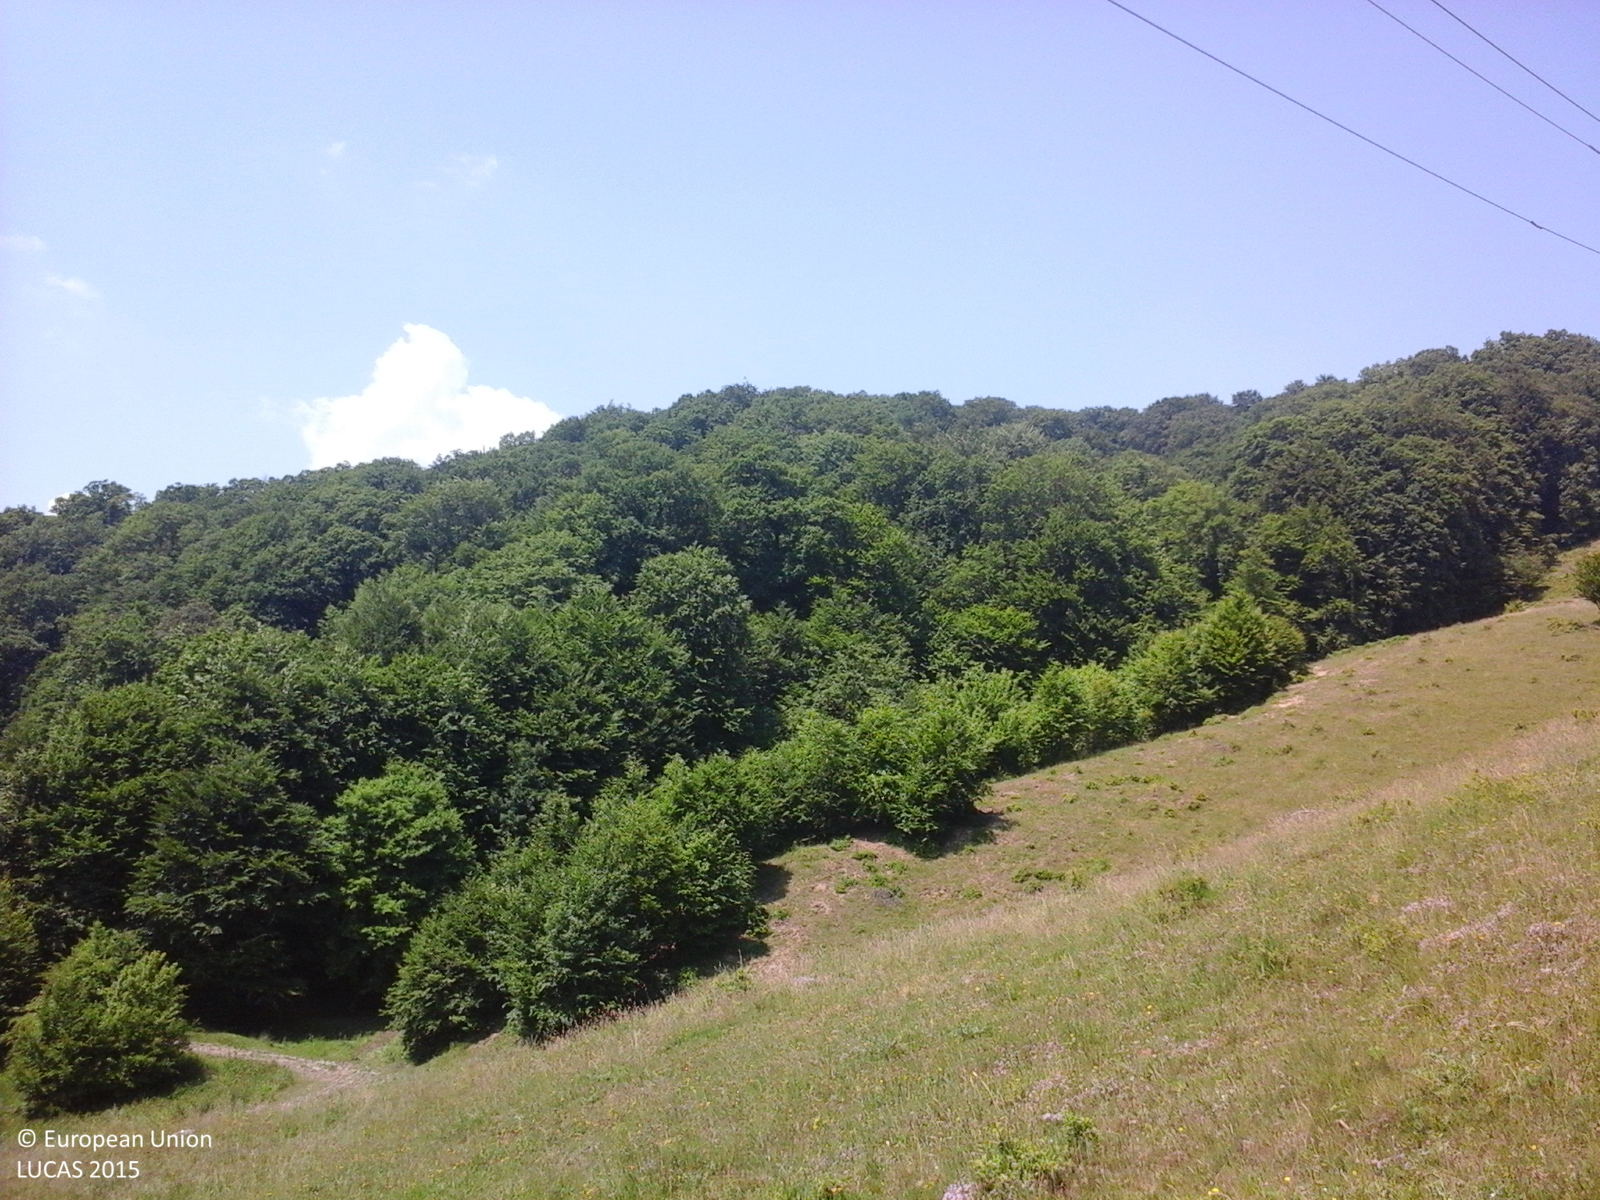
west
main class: Grassland
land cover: Grassland without tree/shrub cover
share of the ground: > 75 %
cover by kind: herbaceous plants 100 %
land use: Agriculture (excluding fallow land and kitchen gardens)
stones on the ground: < 10 %
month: June
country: RO
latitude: 46.6726
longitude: 26.5147
